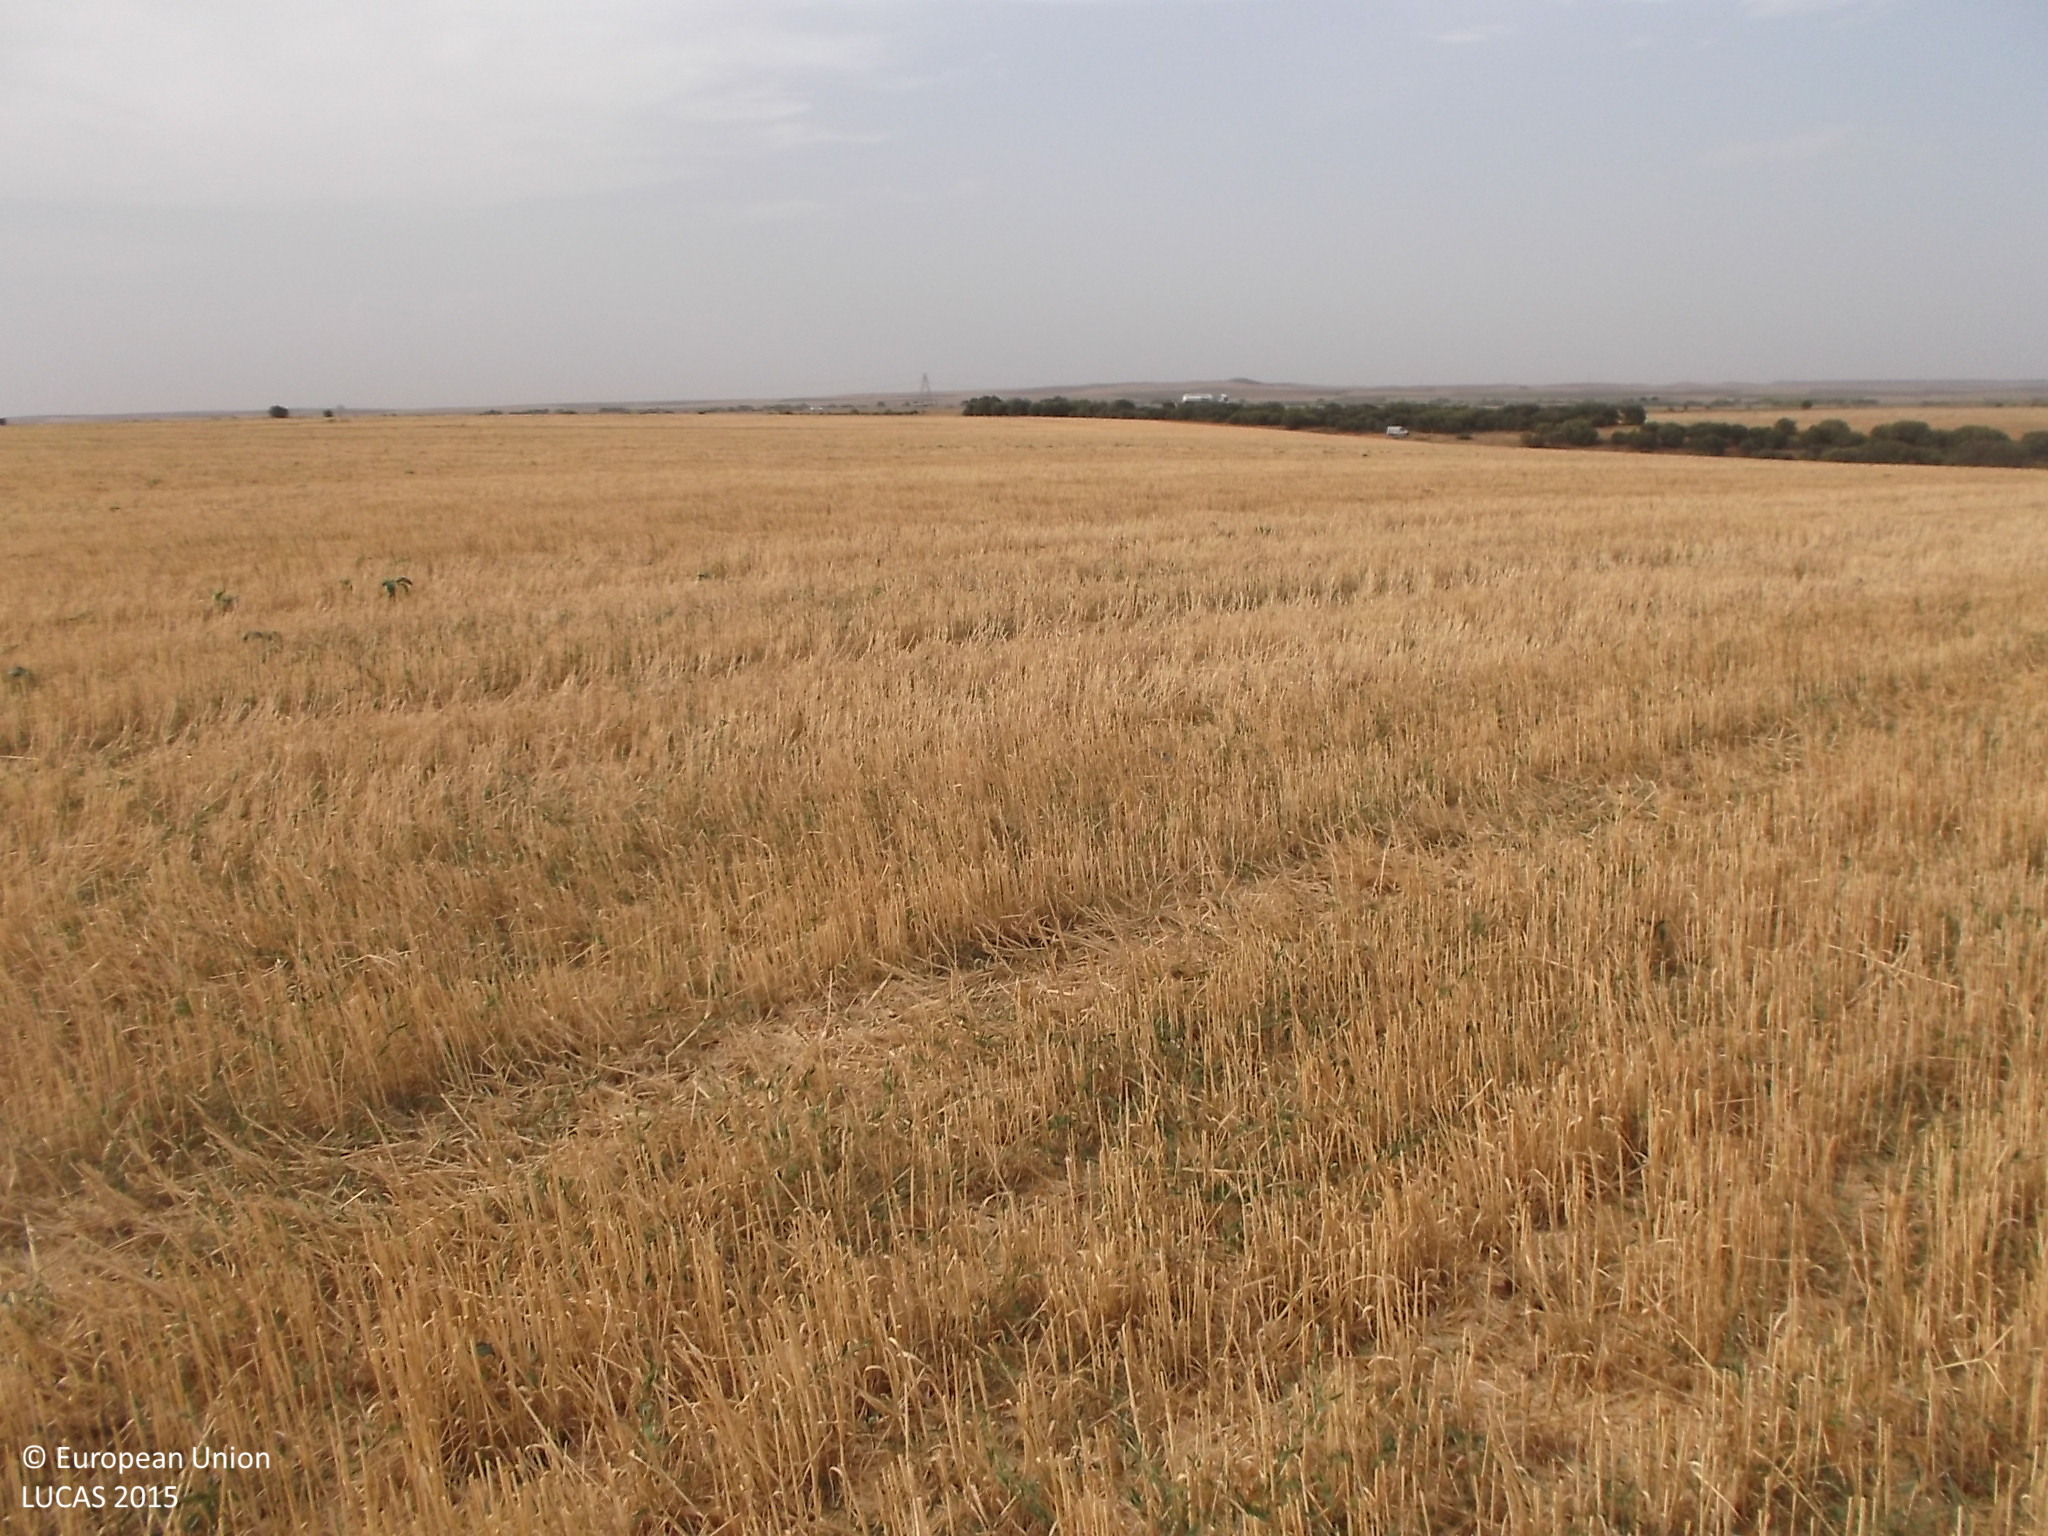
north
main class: Cropland
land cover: Common wheat
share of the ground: < 10 %
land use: Agriculture (excluding fallow land and kitchen gardens)
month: July
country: ES
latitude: 41.5640
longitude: -5.4910
